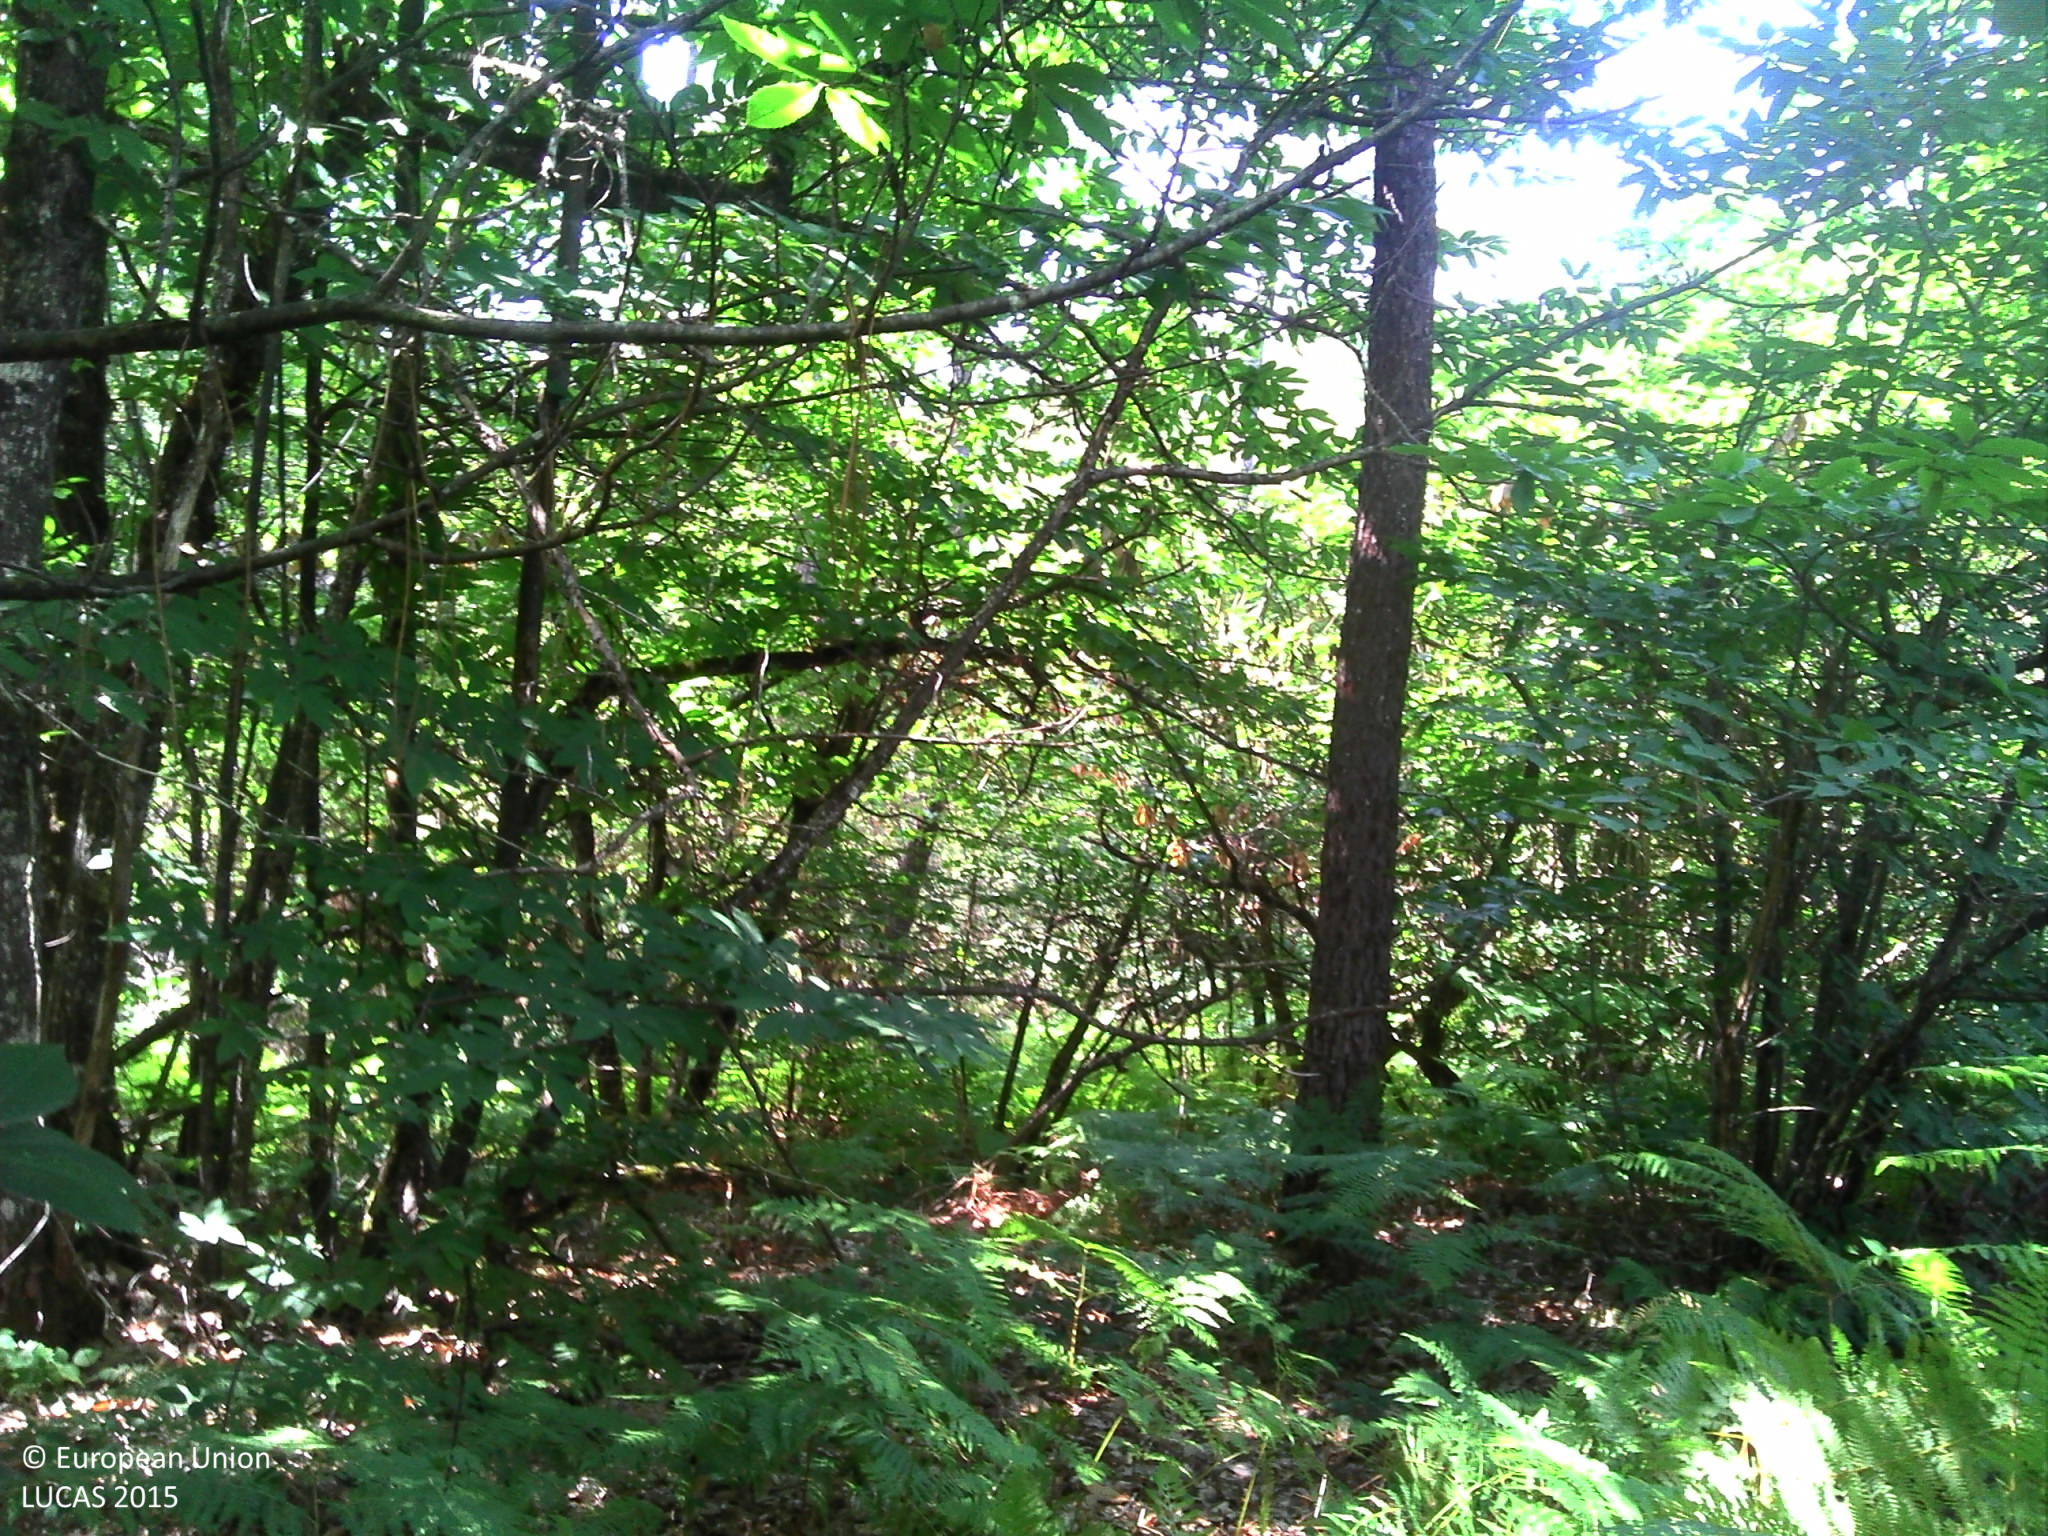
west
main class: Woodland
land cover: Pine dominated mixed woodland
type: mesophytic deciduous forest
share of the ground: > 75 %
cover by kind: broadleaved forest trees 50 %, coniferous forest trees 20 %, herbaceous plants 20 %, shrubs 5 %
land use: Forestry
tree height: > 5 m
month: August
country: FR
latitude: 45.2273
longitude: 0.7820
